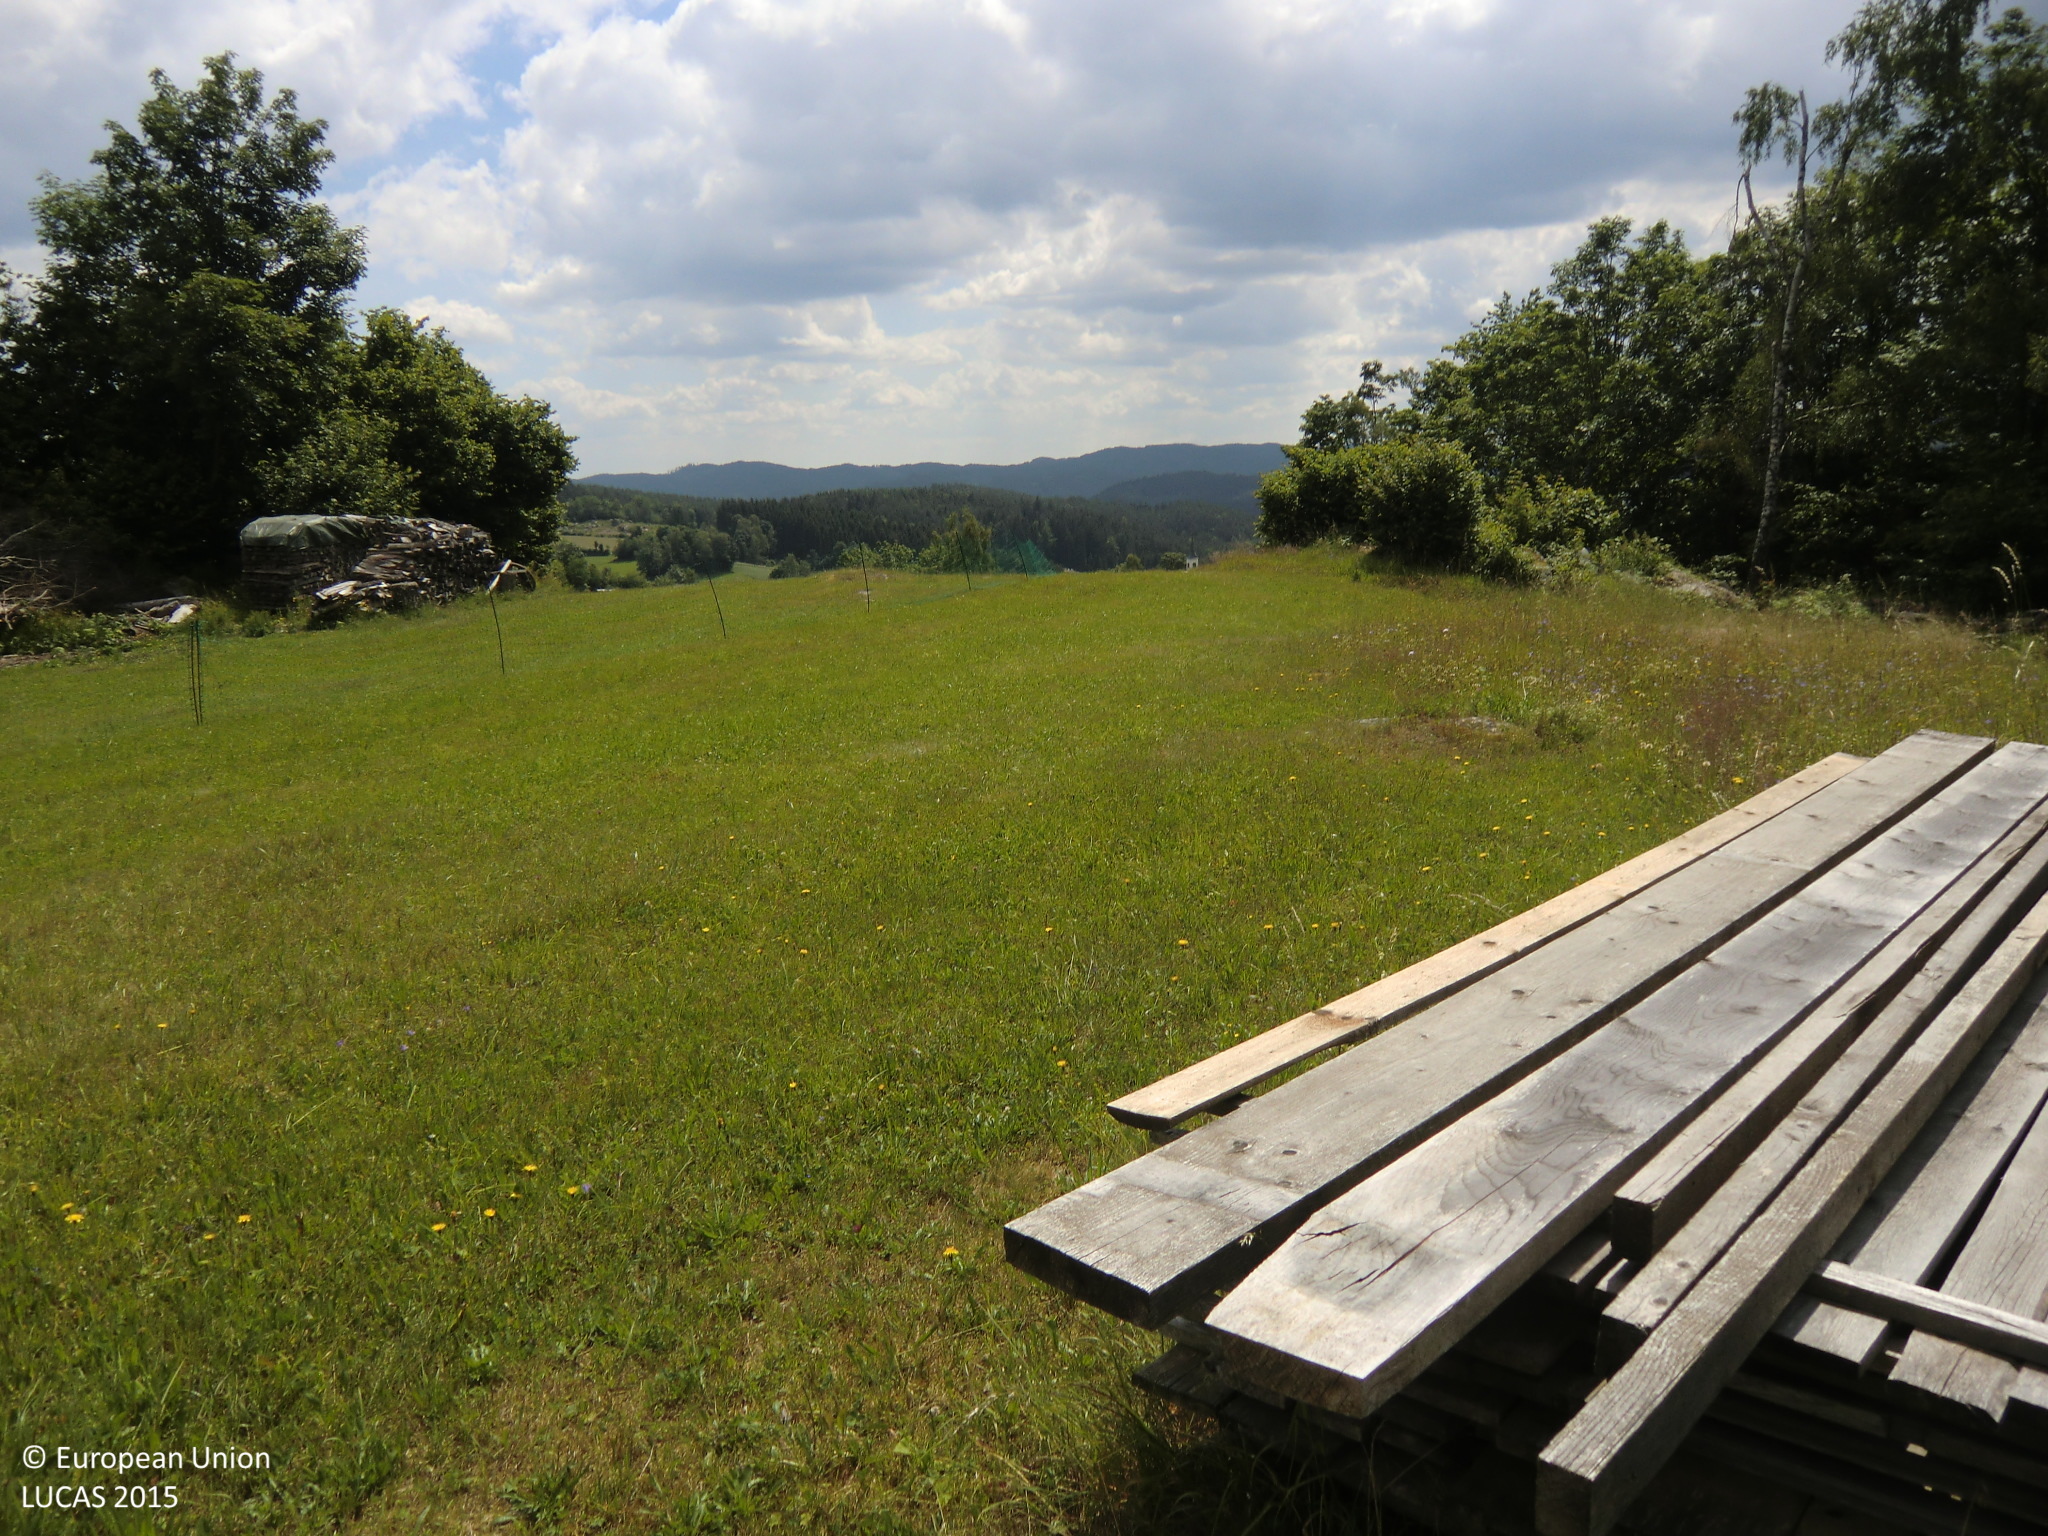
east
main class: Grassland
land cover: Grassland without tree/shrub cover
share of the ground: > 75 %
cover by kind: herbaceous plants 100 %
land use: Agriculture (excluding fallow land and kitchen gardens)
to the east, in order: Grassland without tree/shrub cover; Fences; Grassland without tree/shrub cover; Broadleaved woodland; Artificial constructions in urban areas; Grassland without tree/shrub cover; Single bushes/trees; Grassland without tree/shrub cover; Fences; Grassland without tree/shrub cover; Artificial constructions in urban areas; Grassland without tree/shrub cover; Artificial constructions in urban areas; Grassland without tree/shrub cover; Fences; Paved roads, cycling and walking lanes
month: June
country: AT
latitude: 48.4890
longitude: 14.9944
